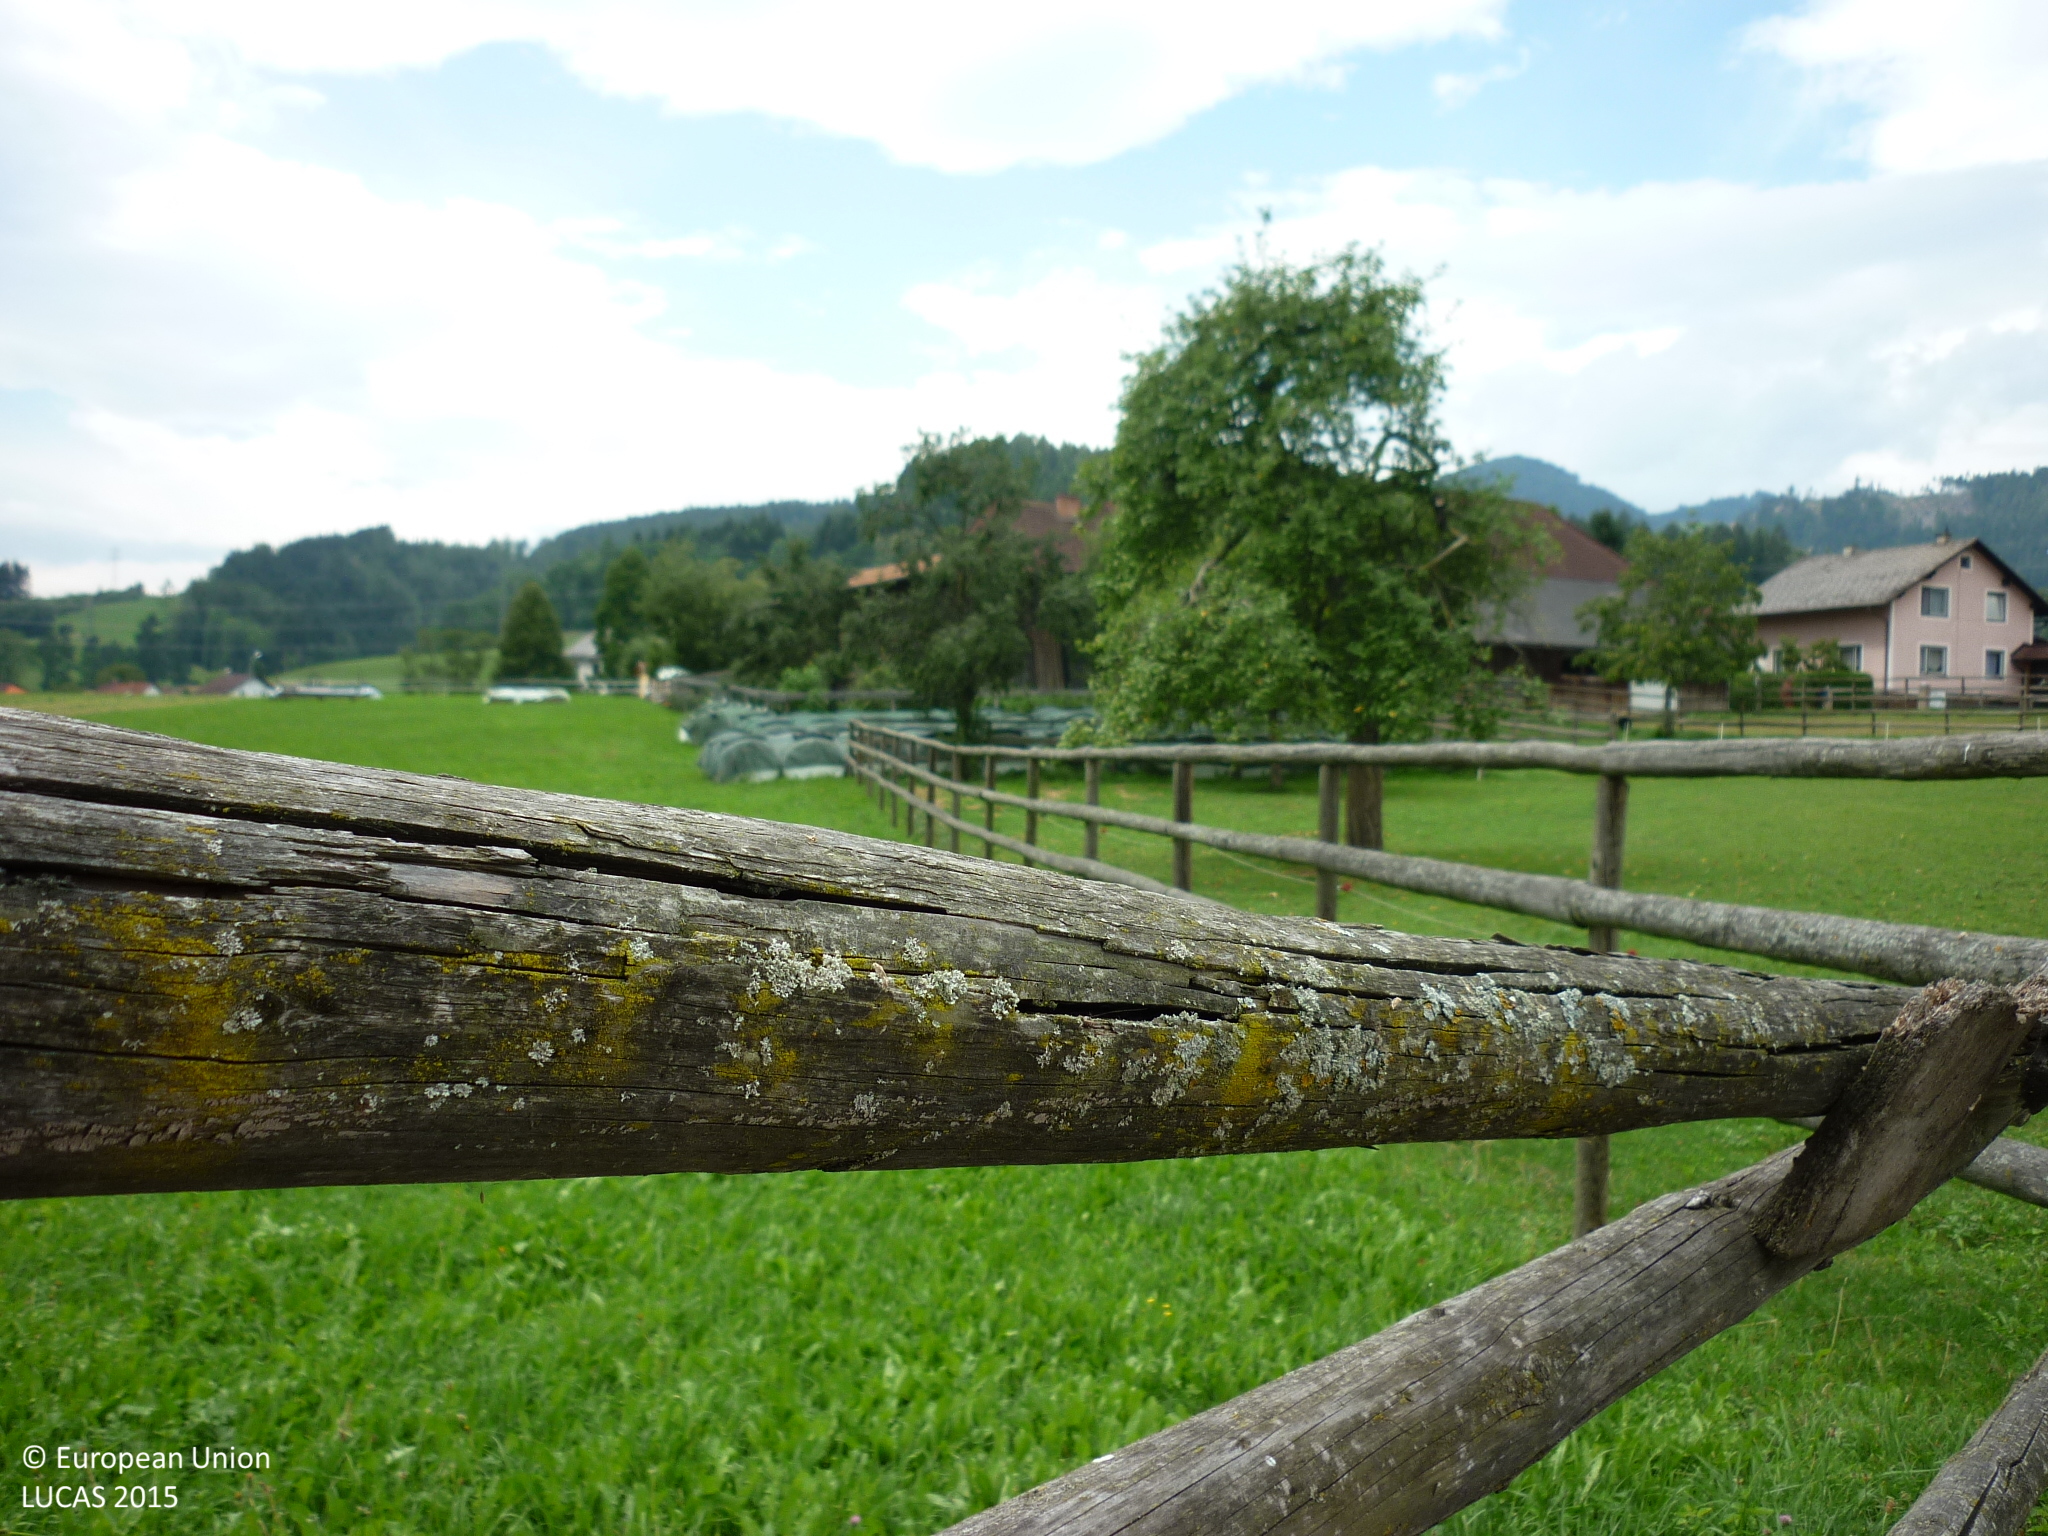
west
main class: Grassland
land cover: Grassland with sparse tree/shrub cover
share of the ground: > 75 %
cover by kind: herbaceous plants 85 %, shrubs 10 %, broadleaved forest trees 5 %
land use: Residential
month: August
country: AT
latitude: 47.4639
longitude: 15.3202
